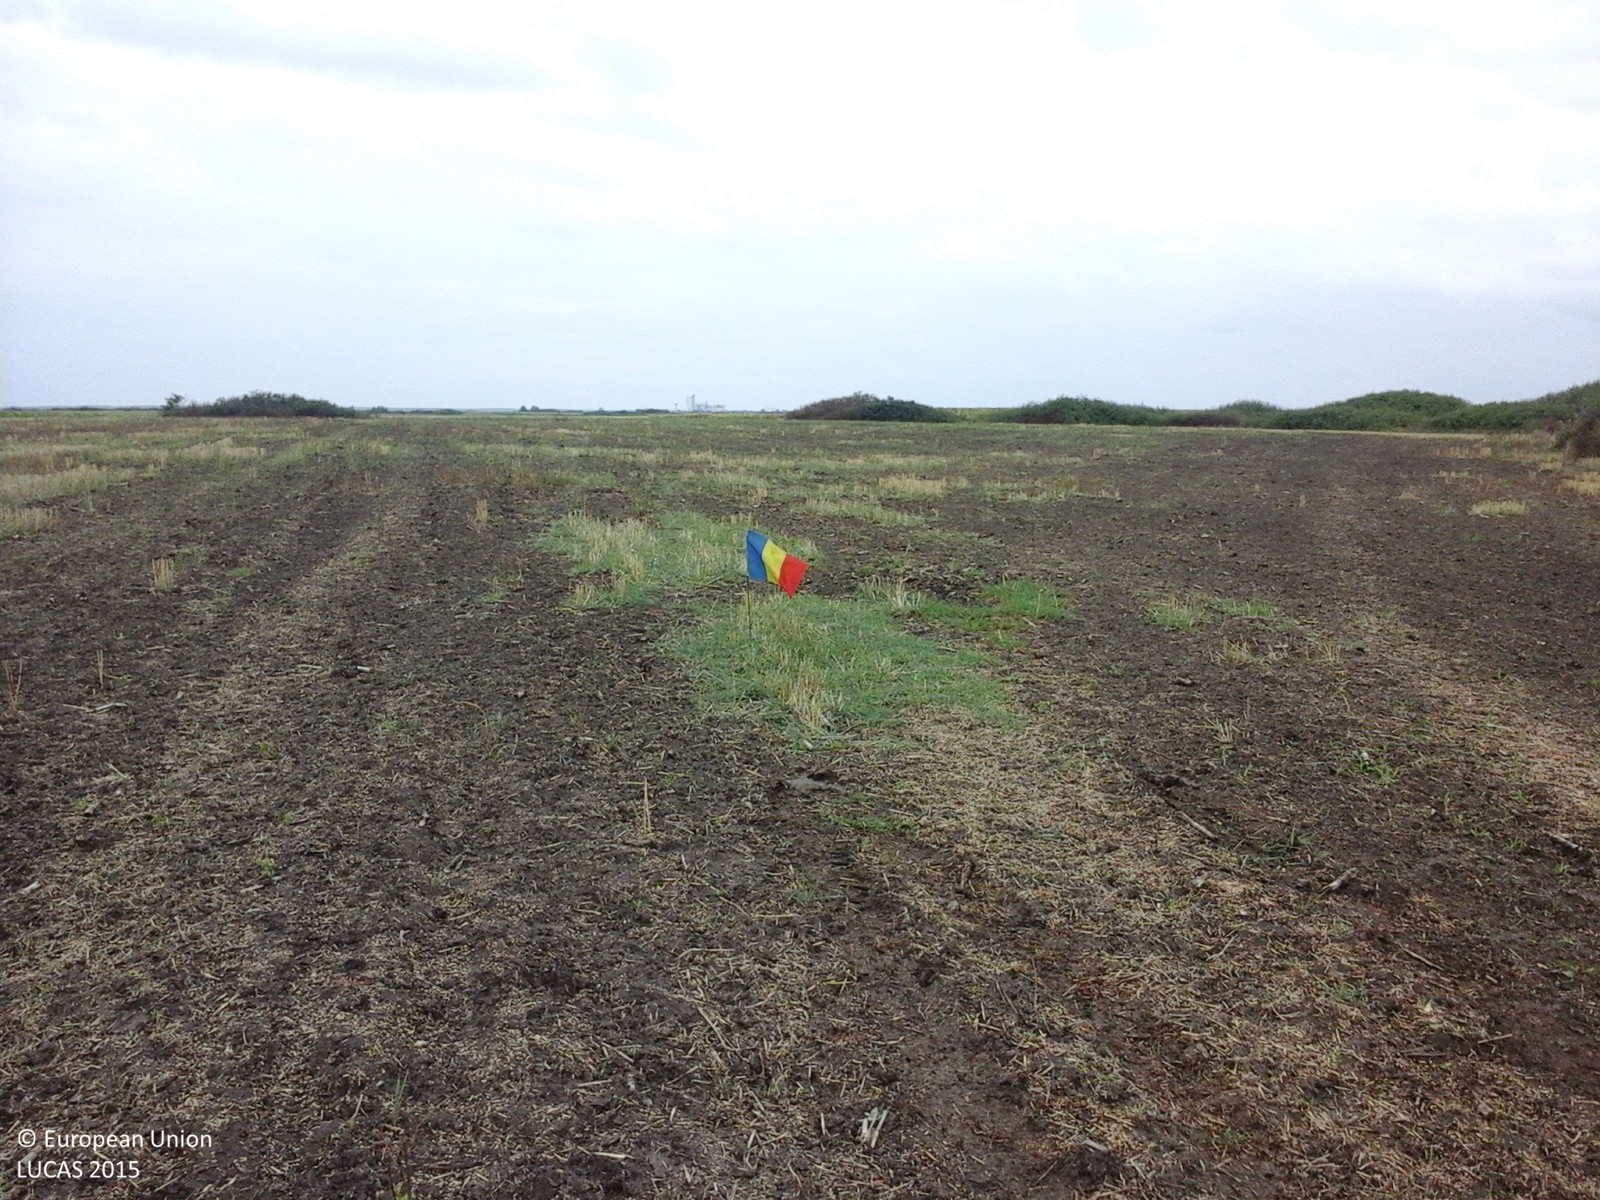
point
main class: Cropland
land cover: Common wheat
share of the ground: < 10 %
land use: Agriculture (excluding fallow land and kitchen gardens)
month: August
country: RO
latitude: 45.5677
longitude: 21.1374
